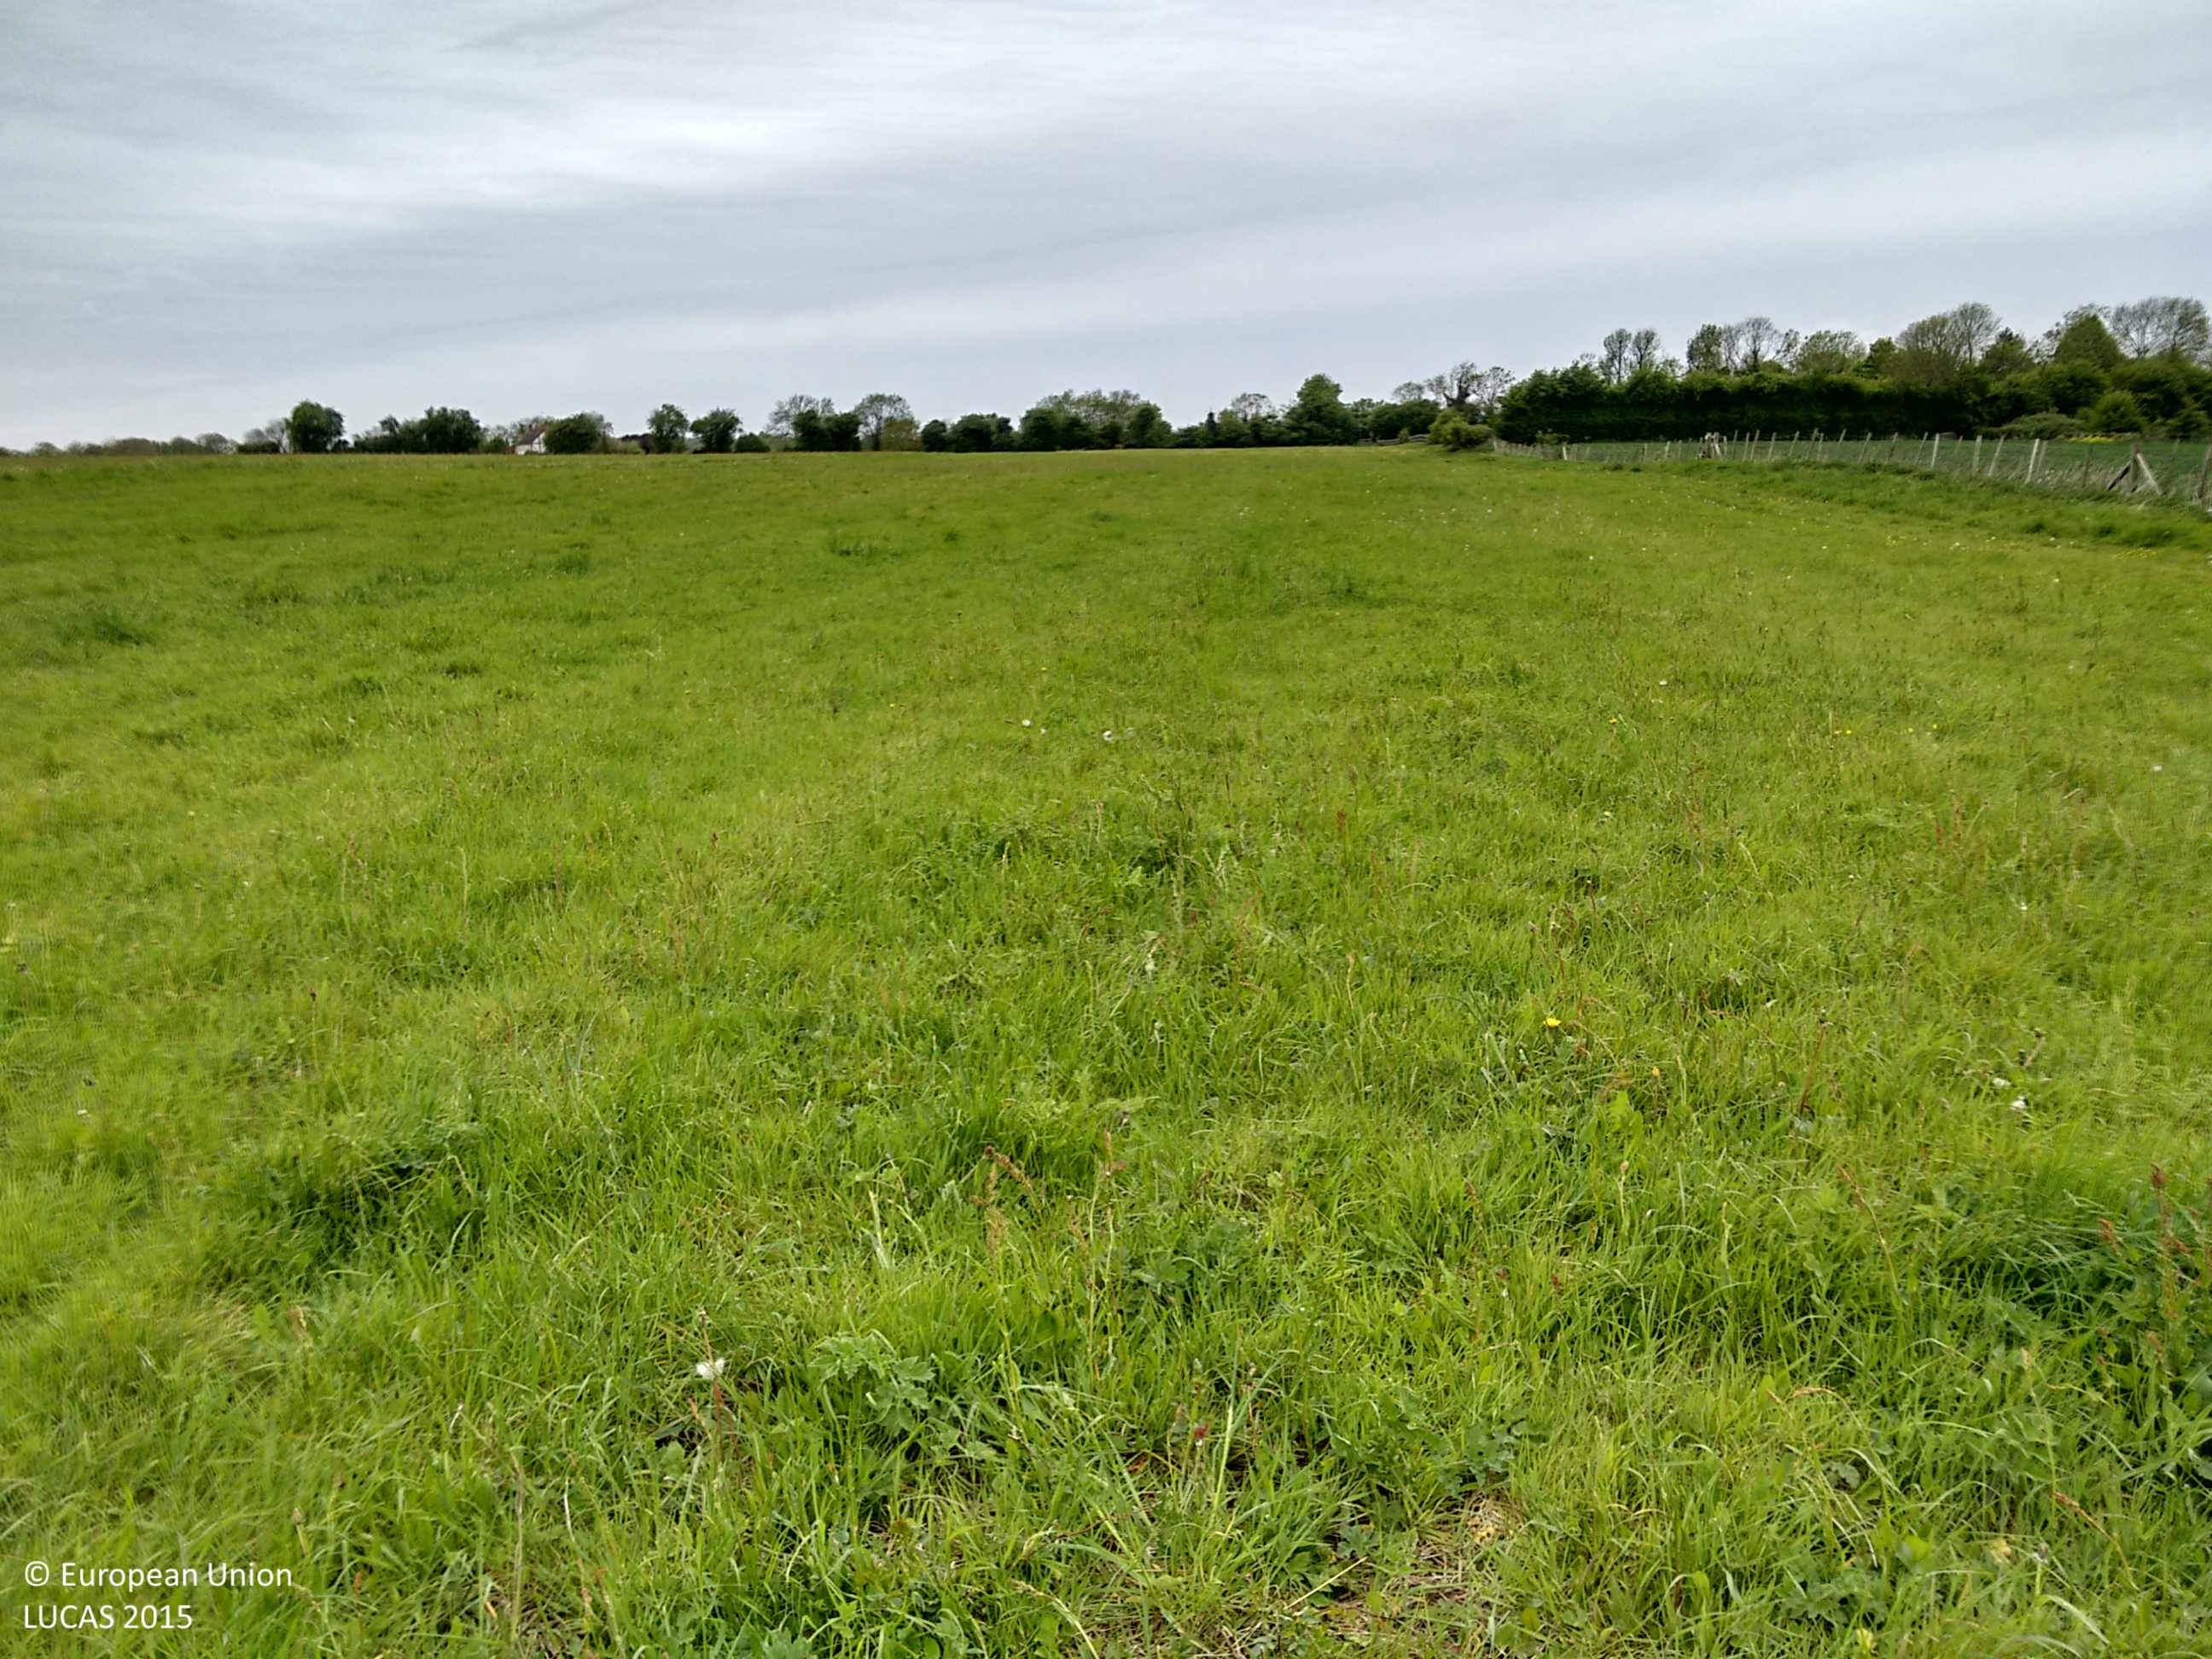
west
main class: Grassland
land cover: Grassland without tree/shrub cover
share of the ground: > 75 %
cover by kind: herbaceous plants 100 %
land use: Agriculture (excluding fallow land and kitchen gardens)
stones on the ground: < 10 %
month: May
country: GB
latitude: 51.3663
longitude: 0.3327
